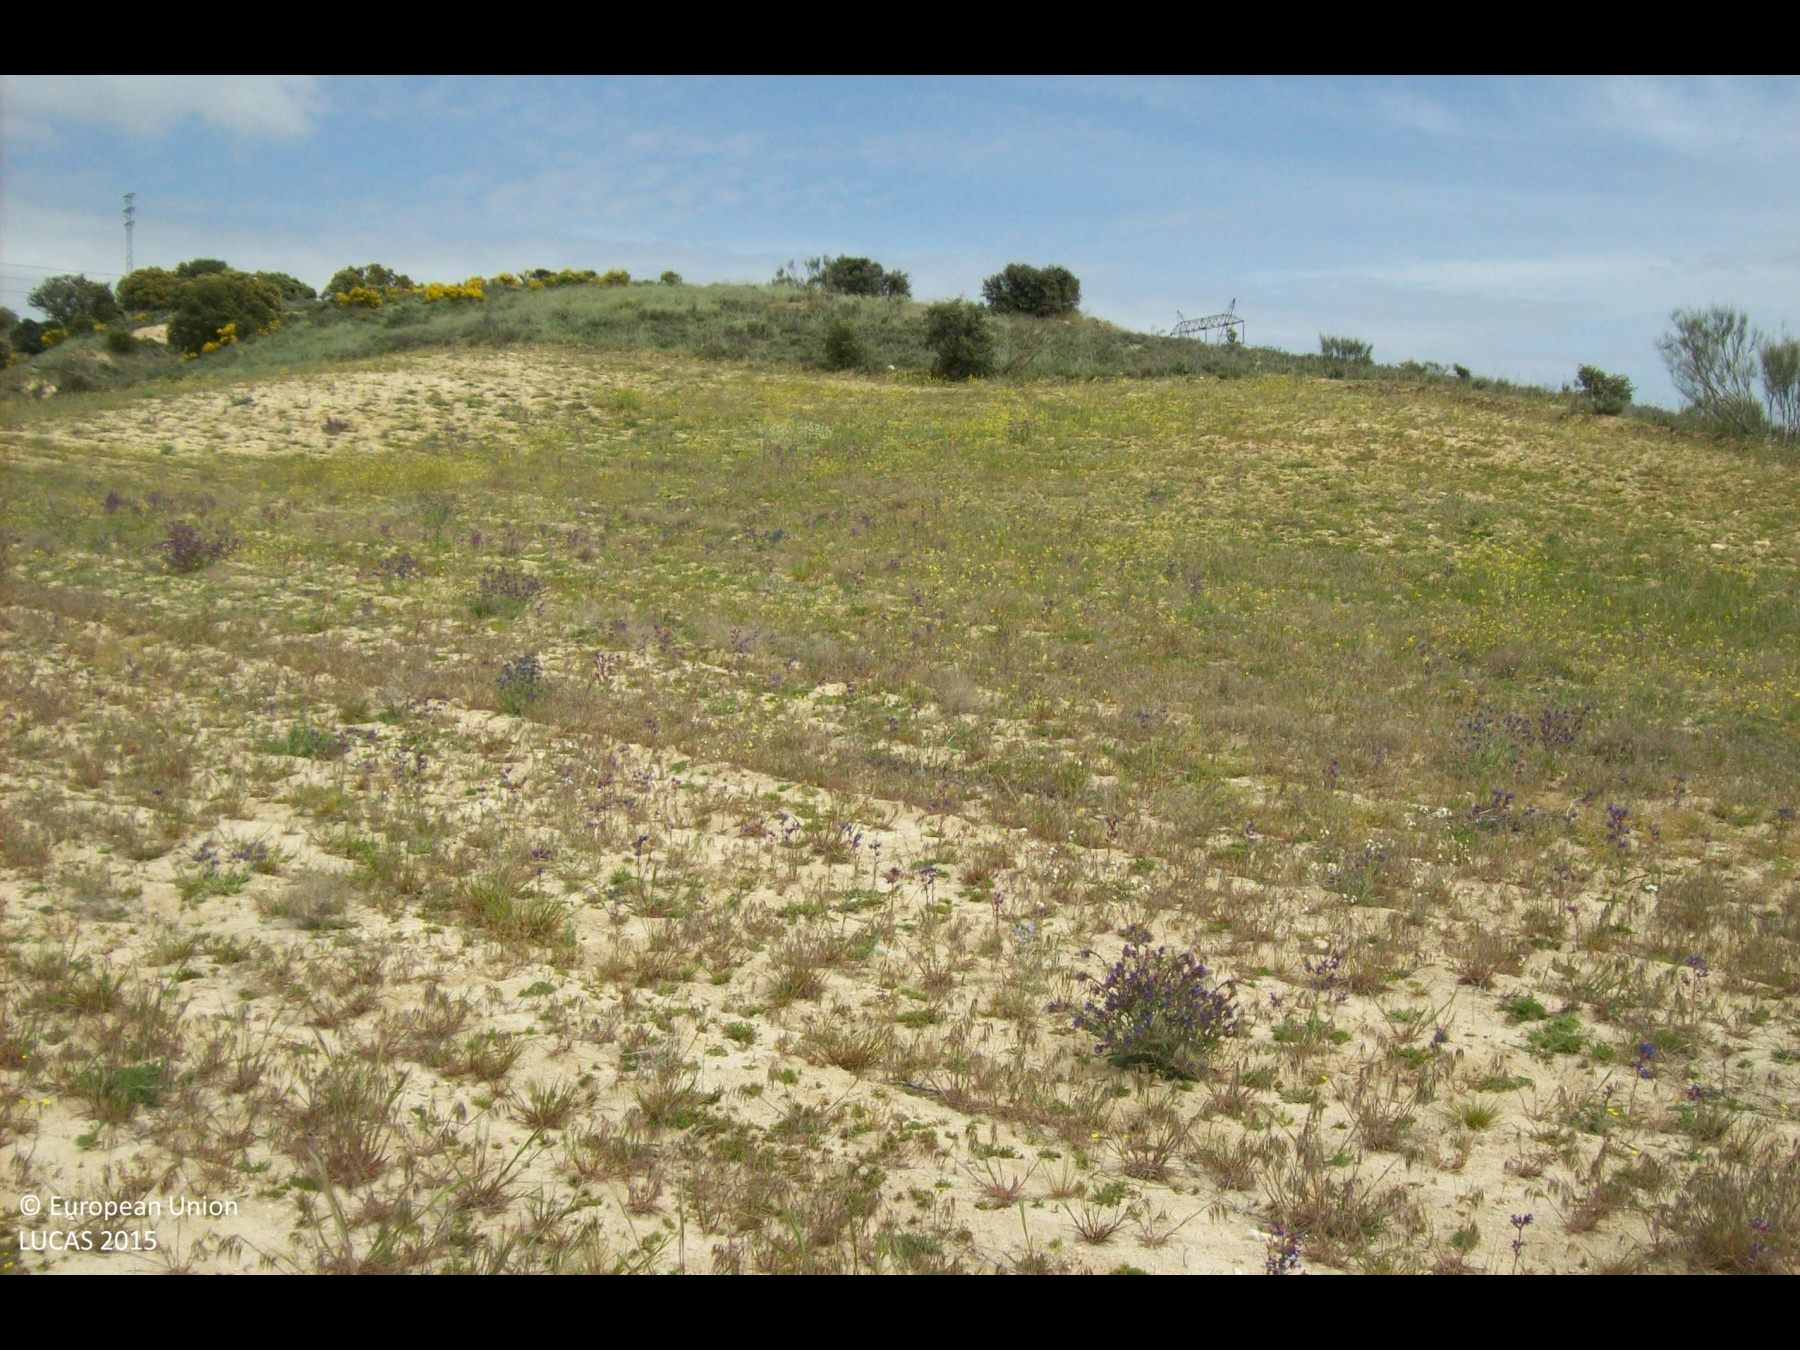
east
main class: Grassland
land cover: Spontaneously vegetated surfaces
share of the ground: 50 - 75 %
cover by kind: herbaceous plants 60 %, unconsolidated bare surface 40 %
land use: Abandoned areas
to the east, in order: Spontaneously vegetated surfaces; Dry stone walls; Shrubland without tree cover; Tracks; Shrubland with sparse tree cover; Shrubland without tree cover; Electric lines; Shrubland with sparse tree cover; Grass margins; Barley; Electric lines; Barley
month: April
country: ES
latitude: 40.4639
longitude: -3.8981
